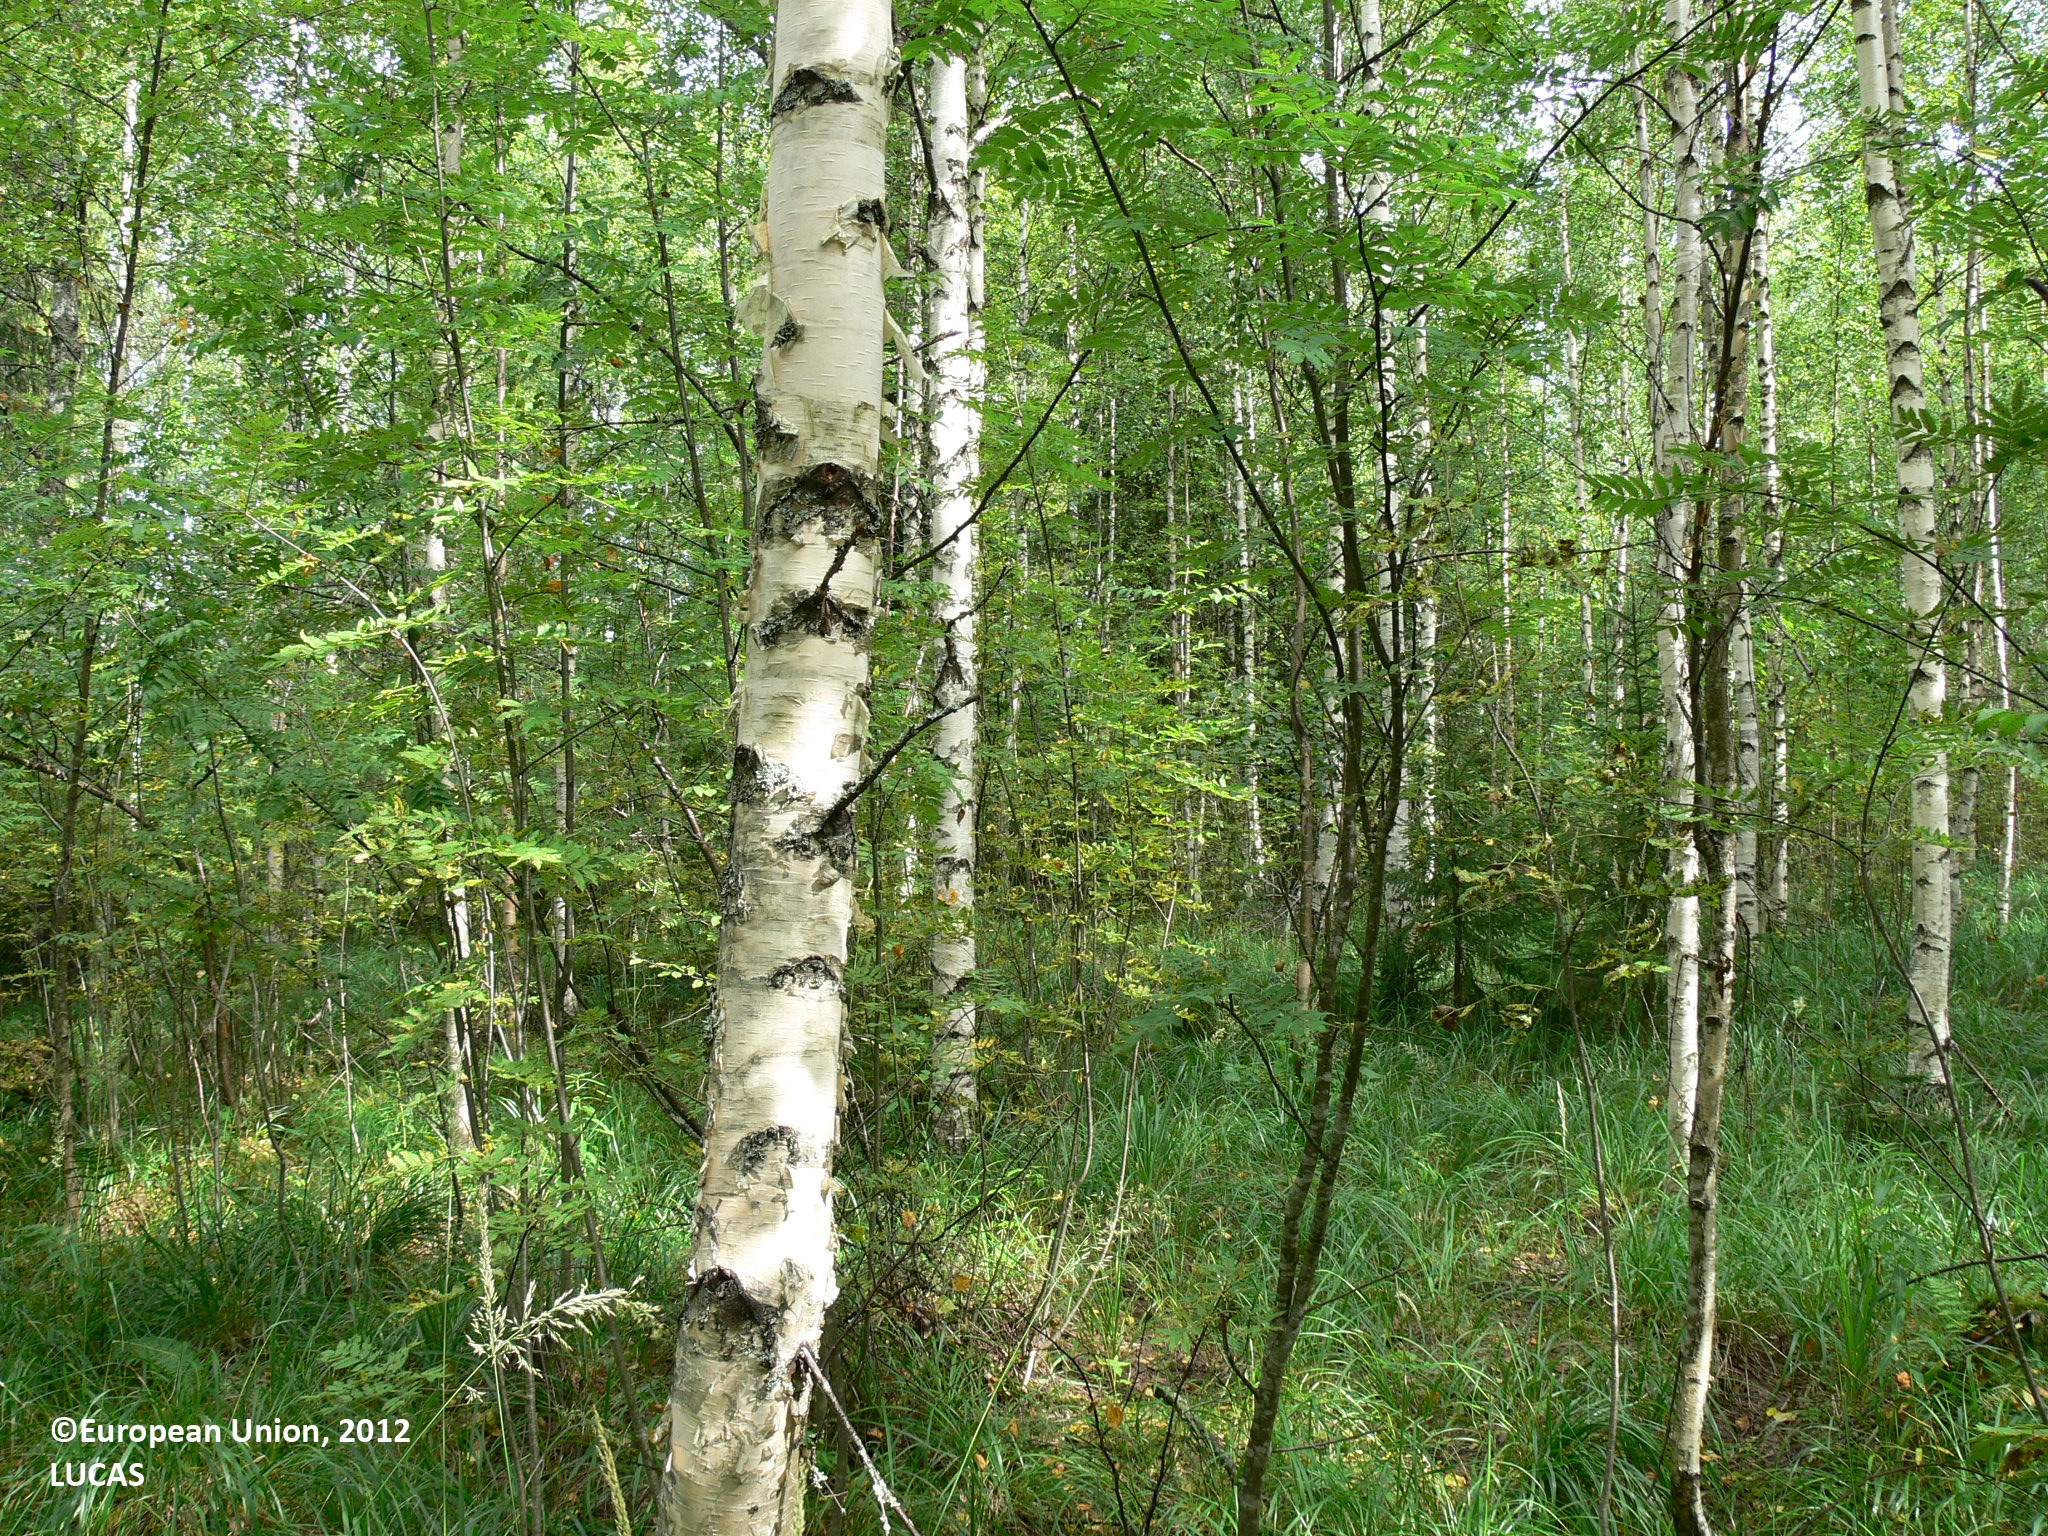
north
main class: Woodland
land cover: Broadleaved woodland
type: boreal forest
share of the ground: > 75 %
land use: Forestry
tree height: > 5 m
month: August
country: FI
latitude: 62.4422
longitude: 30.6941
